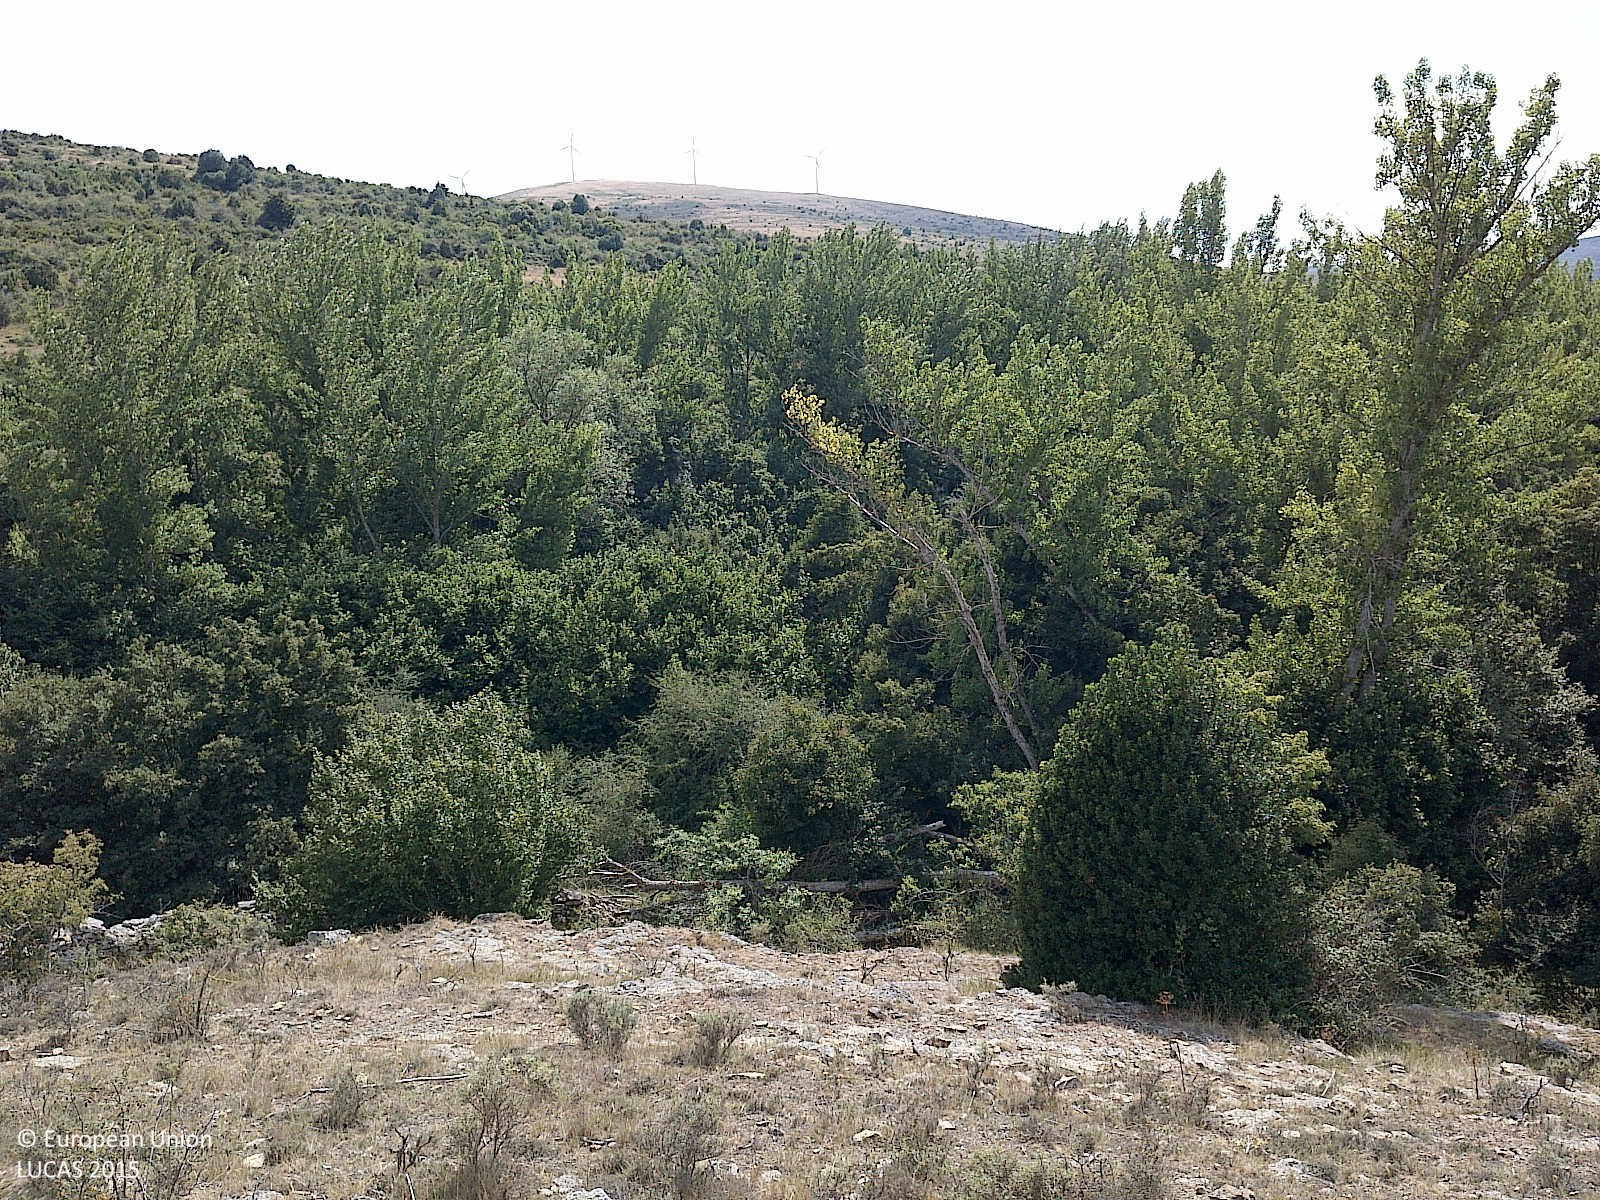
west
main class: Shrubland
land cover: Shrubland with sparse tree cover
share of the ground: 50 - 75 %
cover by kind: shrubs 60 %, herbaceous plants 35 %, broadleaved forest trees 5 %
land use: Semi-natural and natural areas not in use
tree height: < 5 m
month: July
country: ES
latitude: 41.9758
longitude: -2.2873
